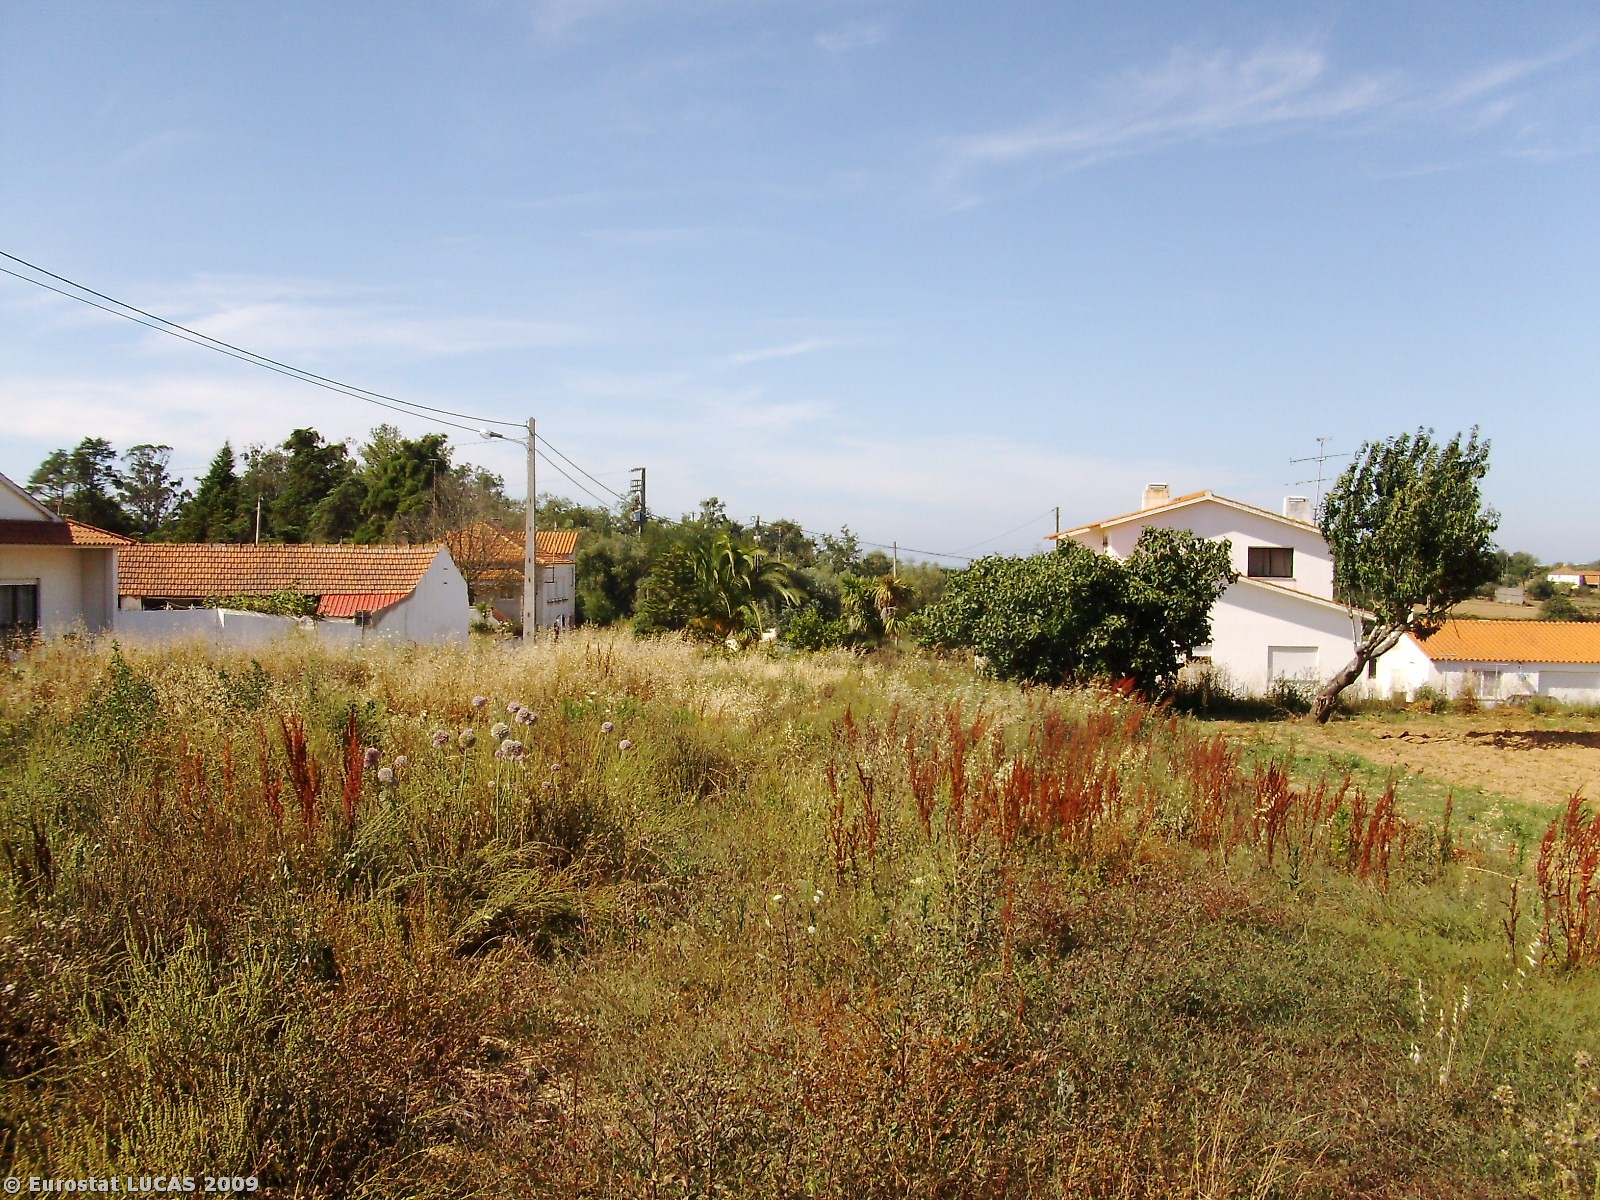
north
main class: Grassland
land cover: Spontaneously vegetated surfaces
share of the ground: > 75 %
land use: Fallow land
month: July
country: PT
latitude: 39.4708
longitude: -8.9746
